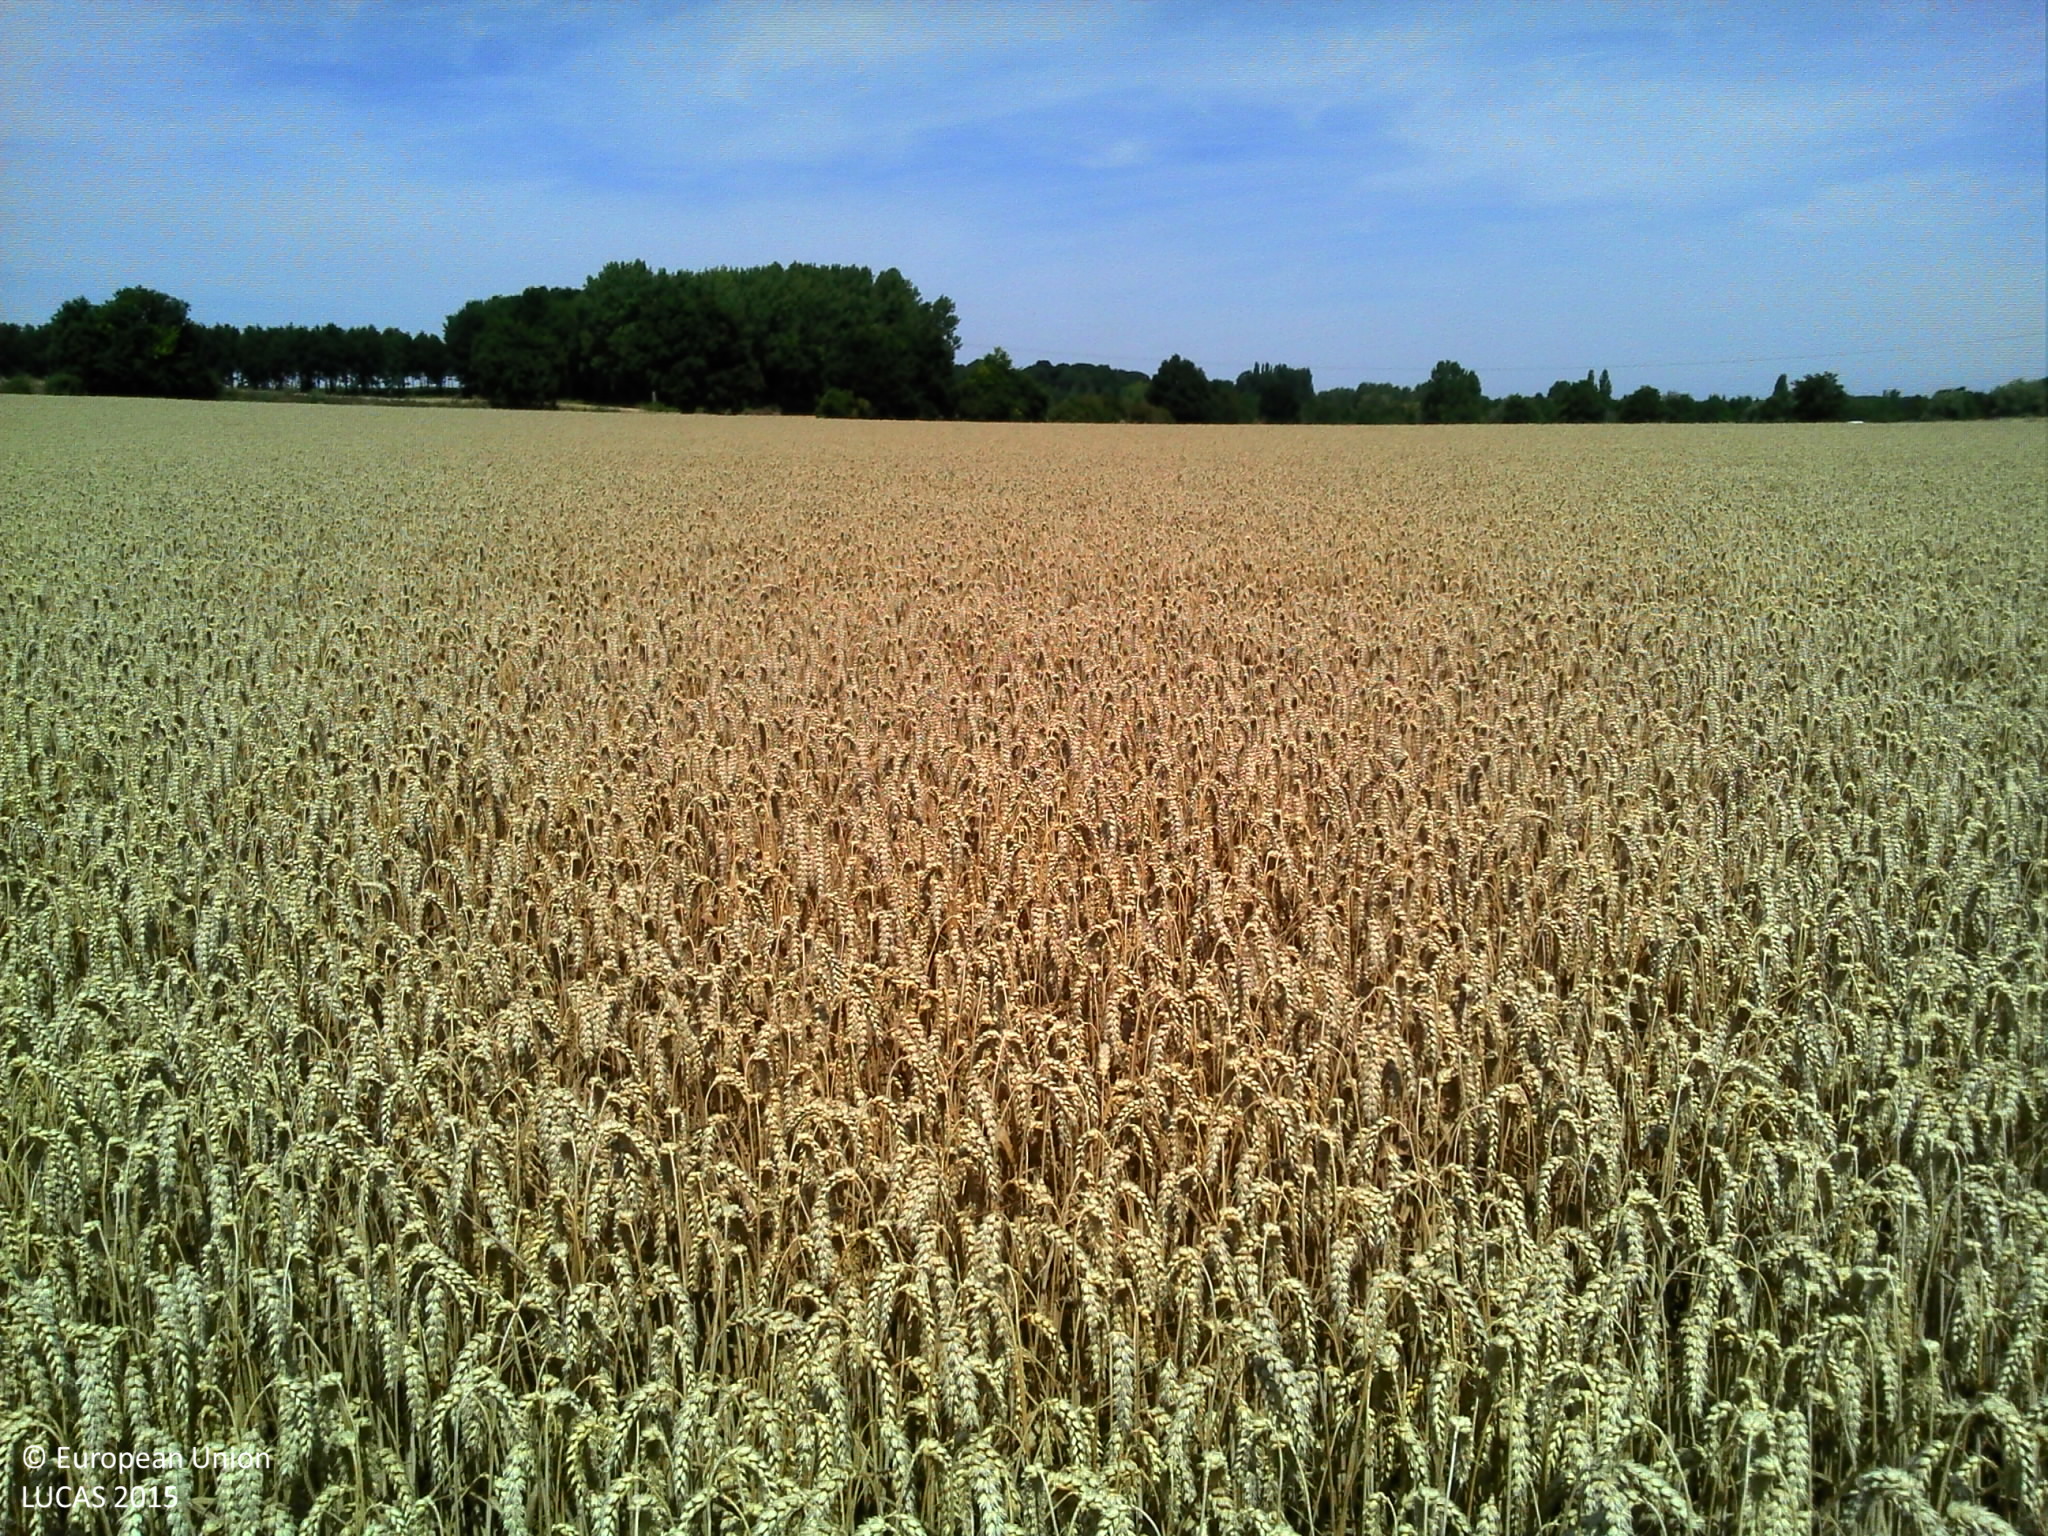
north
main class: Cropland
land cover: Common wheat
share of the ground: > 75 %
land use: Agriculture (excluding fallow land and kitchen gardens)
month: August
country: FR
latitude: 50.2998
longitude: 3.0975
